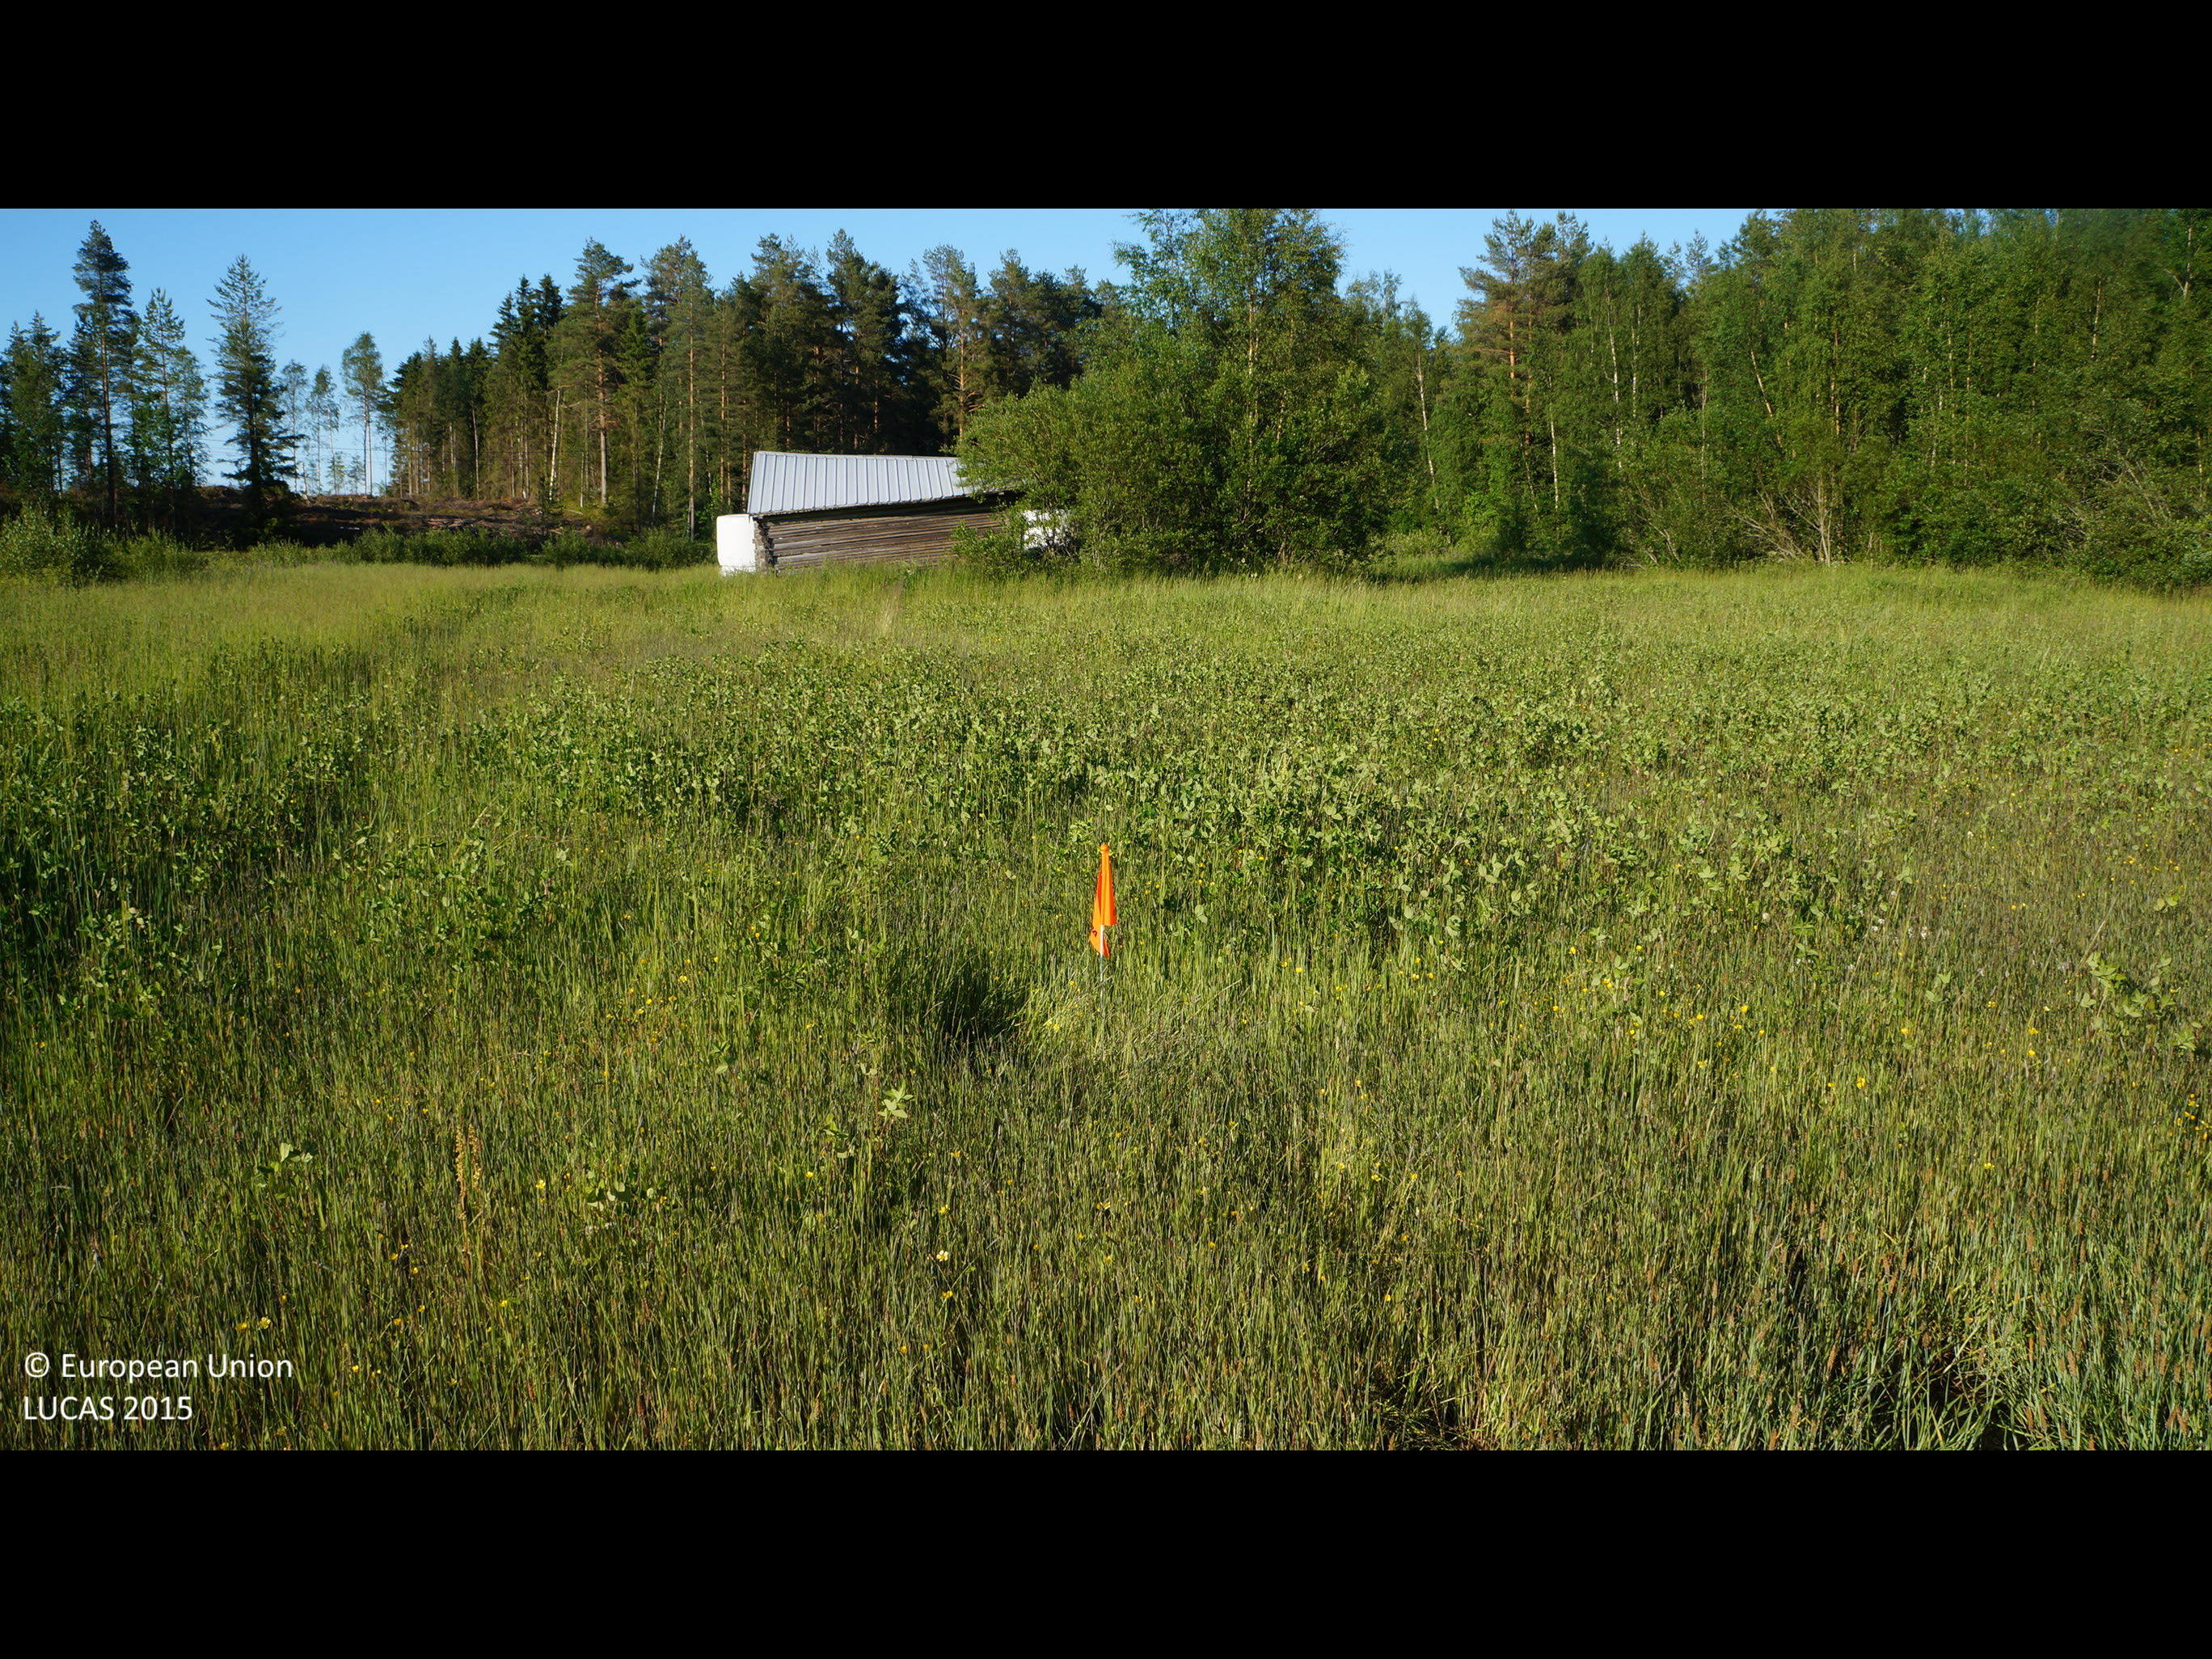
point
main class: Cropland
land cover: Other leguminous and mixtures for fodder
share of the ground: > 75 %
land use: Agriculture (excluding fallow land and kitchen gardens)
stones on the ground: < 10 %
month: July
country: FI
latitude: 63.6655
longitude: 22.9219
